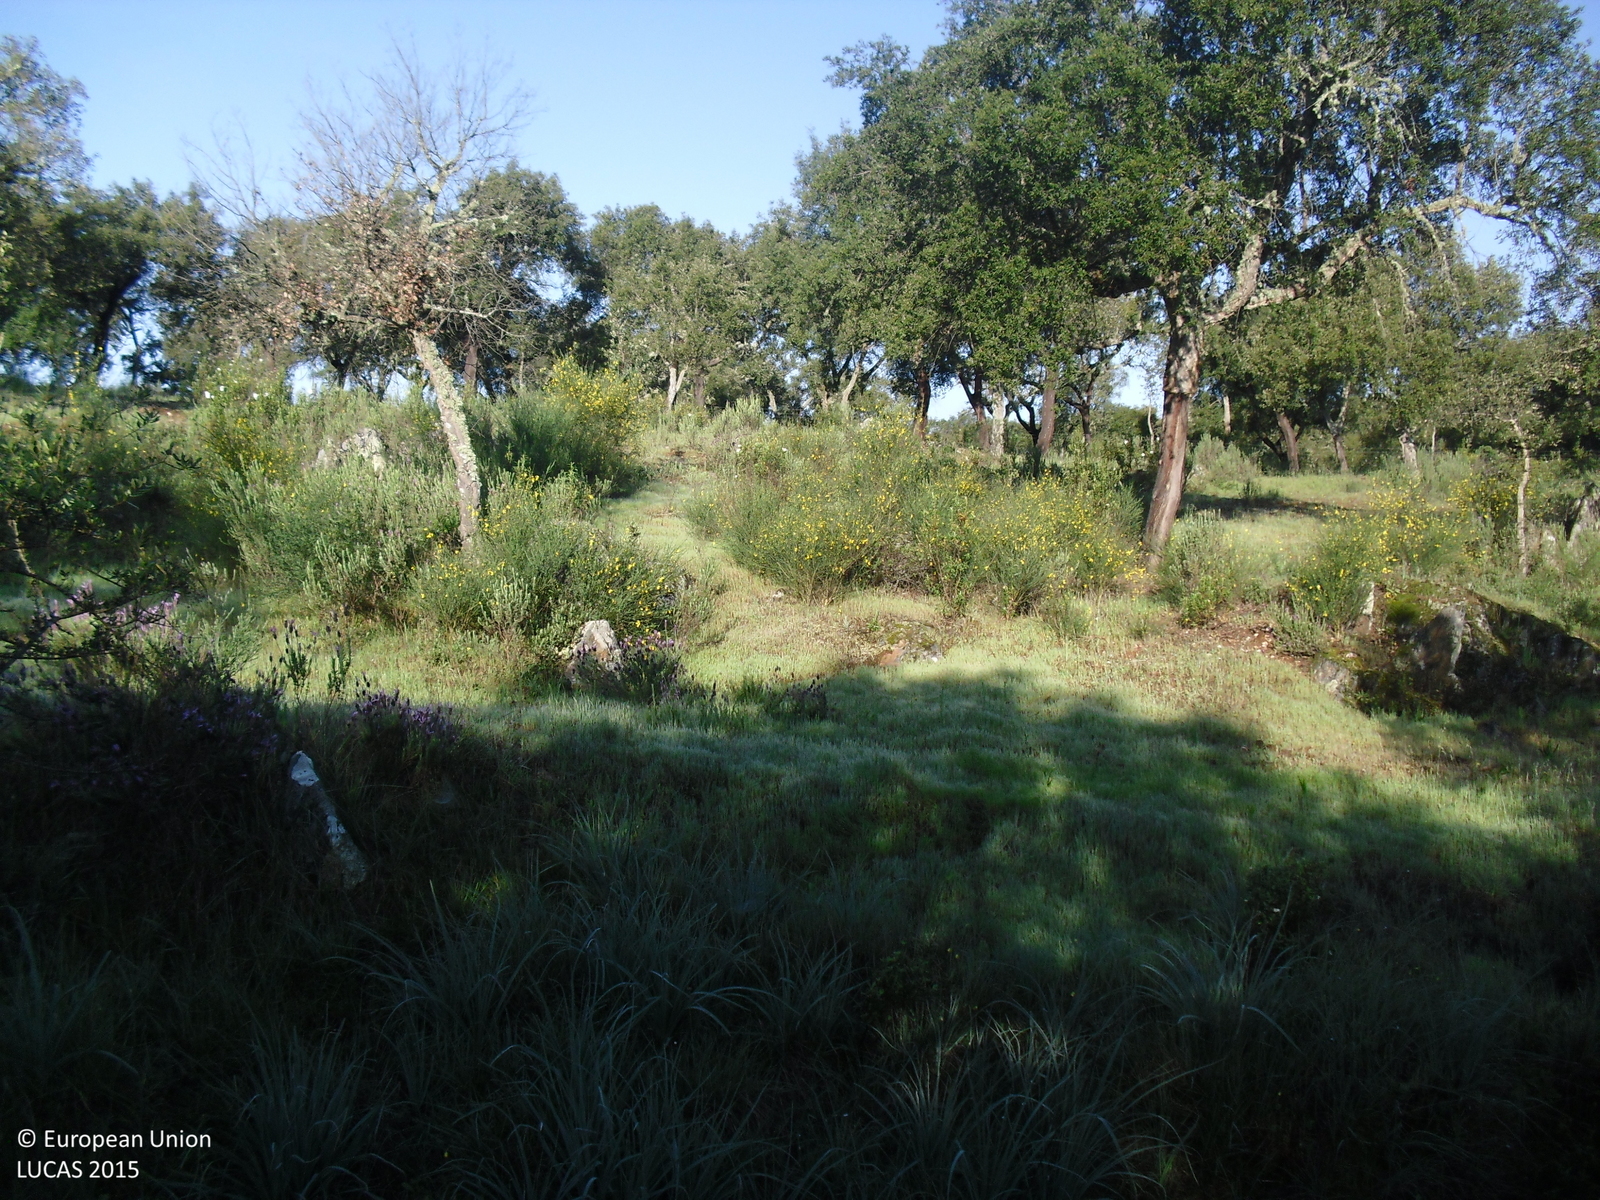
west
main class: Woodland
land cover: Broadleaved woodland
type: broadleaved evergreen forest
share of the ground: 25 - 50 %
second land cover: Grassland without tree/shrub cover
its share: > 75 %
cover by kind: herbaceous plants 60 %, broadleaved forest trees 30 %, shrubs 10 %
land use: Forestry
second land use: Agriculture (excluding fallow land and kitchen gardens)
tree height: > 5 m
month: April
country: ES
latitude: 39.6418
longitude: -7.4931
